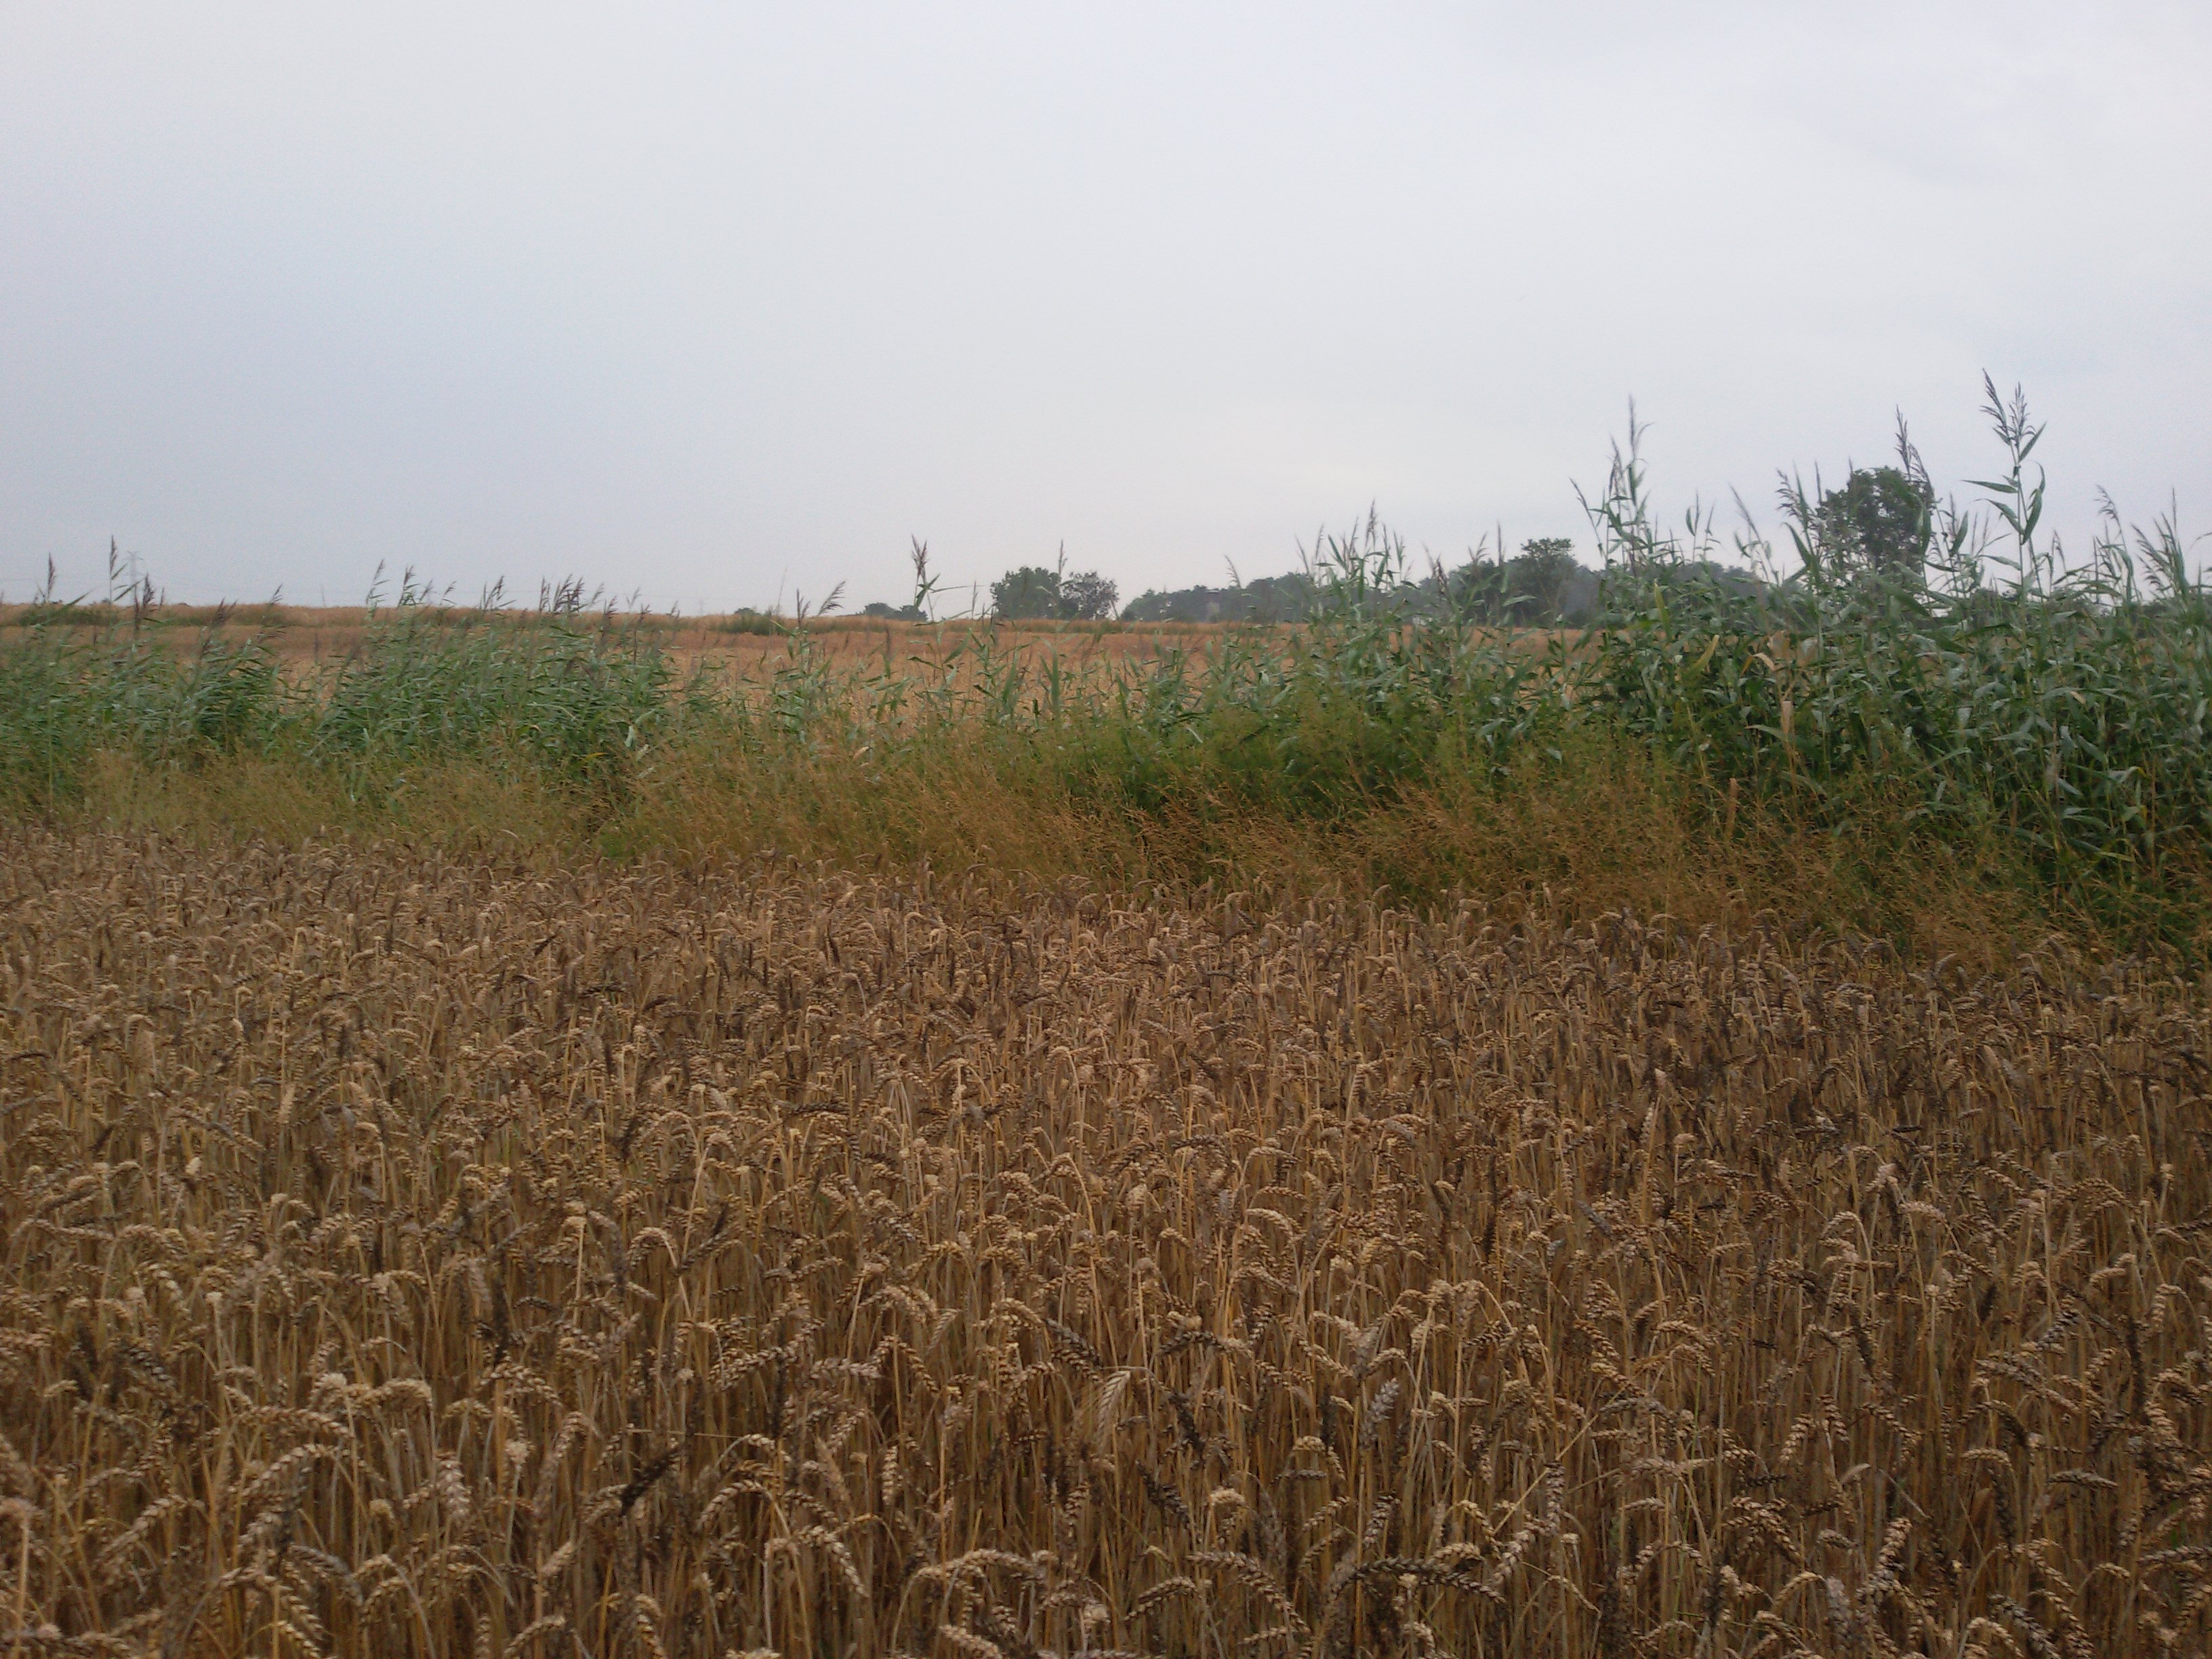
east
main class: Cropland
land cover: Common wheat
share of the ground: > 75 %
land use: Agriculture (excluding fallow land and kitchen gardens)
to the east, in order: Common wheat; Spontaneously vegetated surfaces; Ditches and canals; Grass margins; Triticale; Common wheat
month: July
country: PL
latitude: 52.2843
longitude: 17.5033
